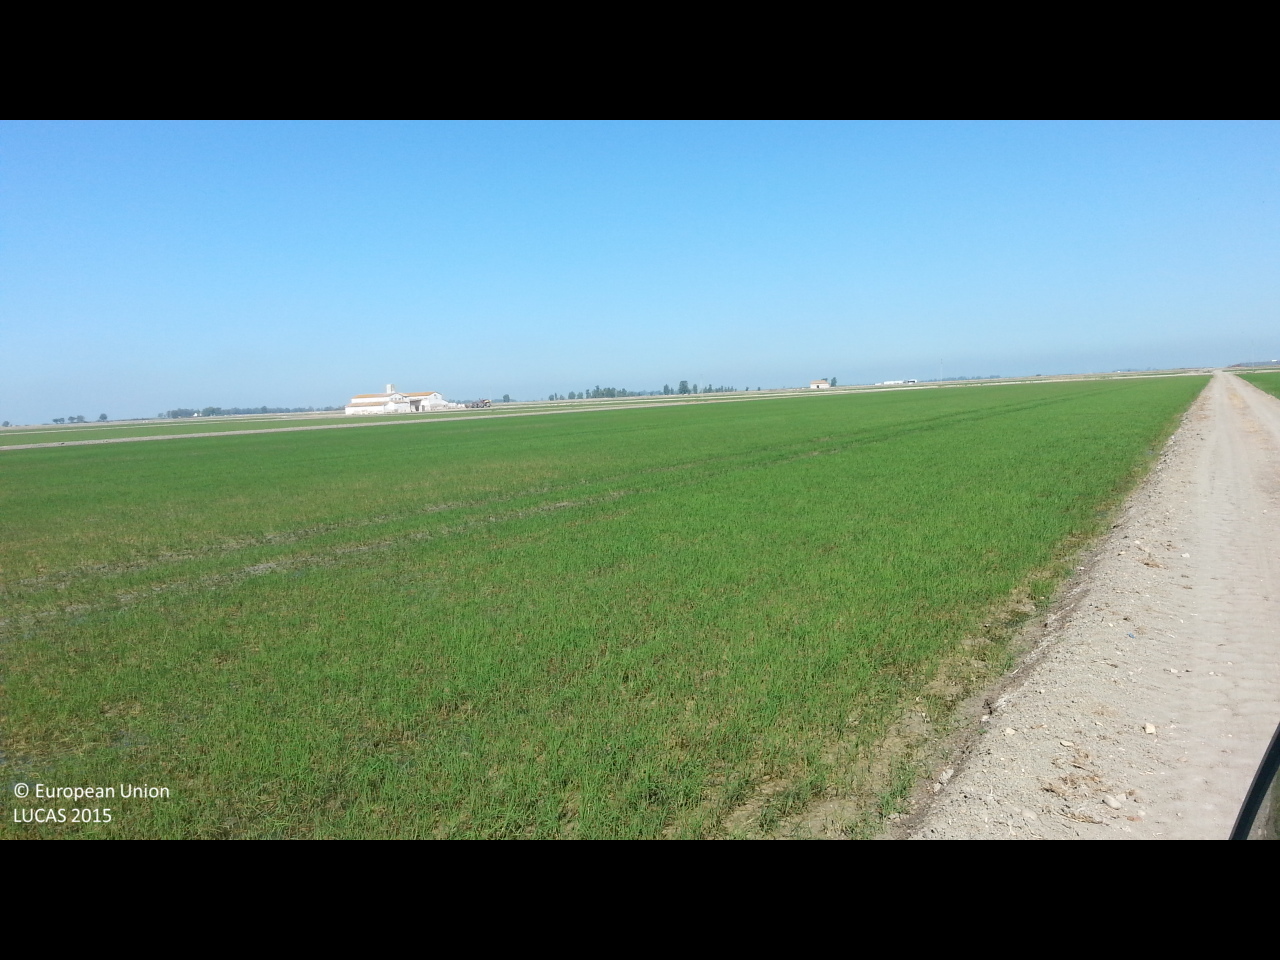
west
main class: Cropland
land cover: Rice
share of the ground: > 75 %
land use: Agriculture (excluding fallow land and kitchen gardens)
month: June
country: ES
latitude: 37.0620
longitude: -6.0211
